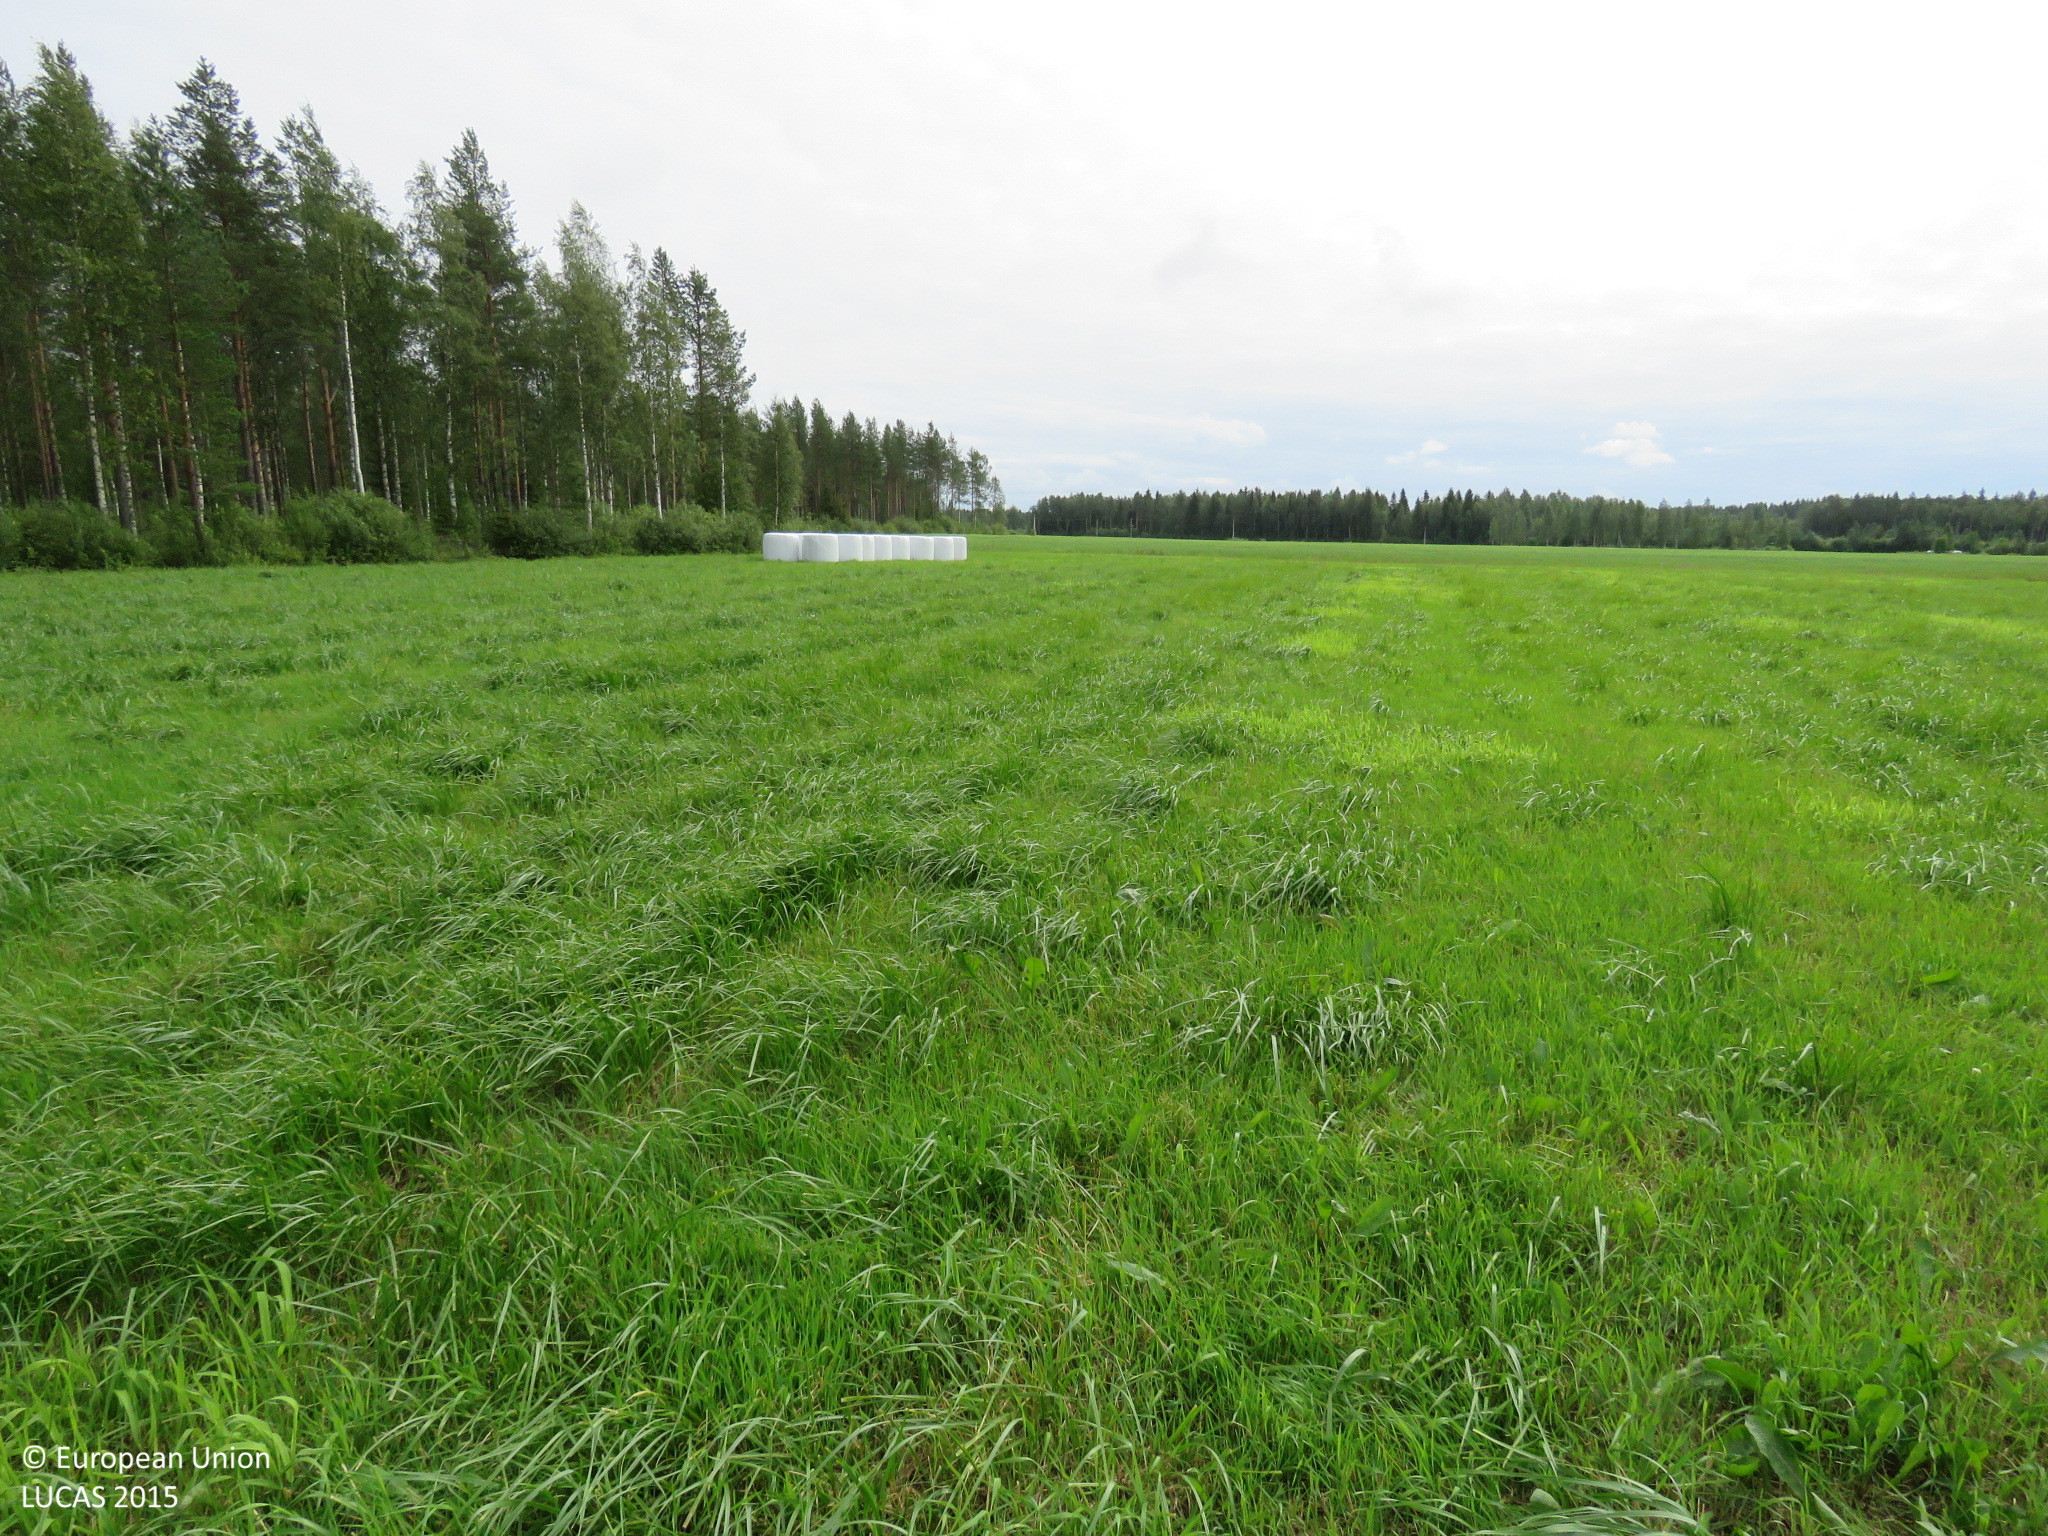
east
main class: Cropland
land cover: Temporary grasslands
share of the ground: > 75 %
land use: Agriculture (excluding fallow land and kitchen gardens)
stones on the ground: < 10 %
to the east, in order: Temporary grasslands; Ditches and canals; Abandoned hedges; Pine dominated mixed woodland; Shruby margins; Ditches and canals; Grass margins; Tracks; Grass margins; Ditches and canals; Barley; Grass margins; Ditches and canals; Shruby margins; Other mixed woodland; Pine dominated coniferous woodland; Ditches and canals; Other mixed woodland
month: July
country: FI
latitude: 64.6085
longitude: 26.7791
